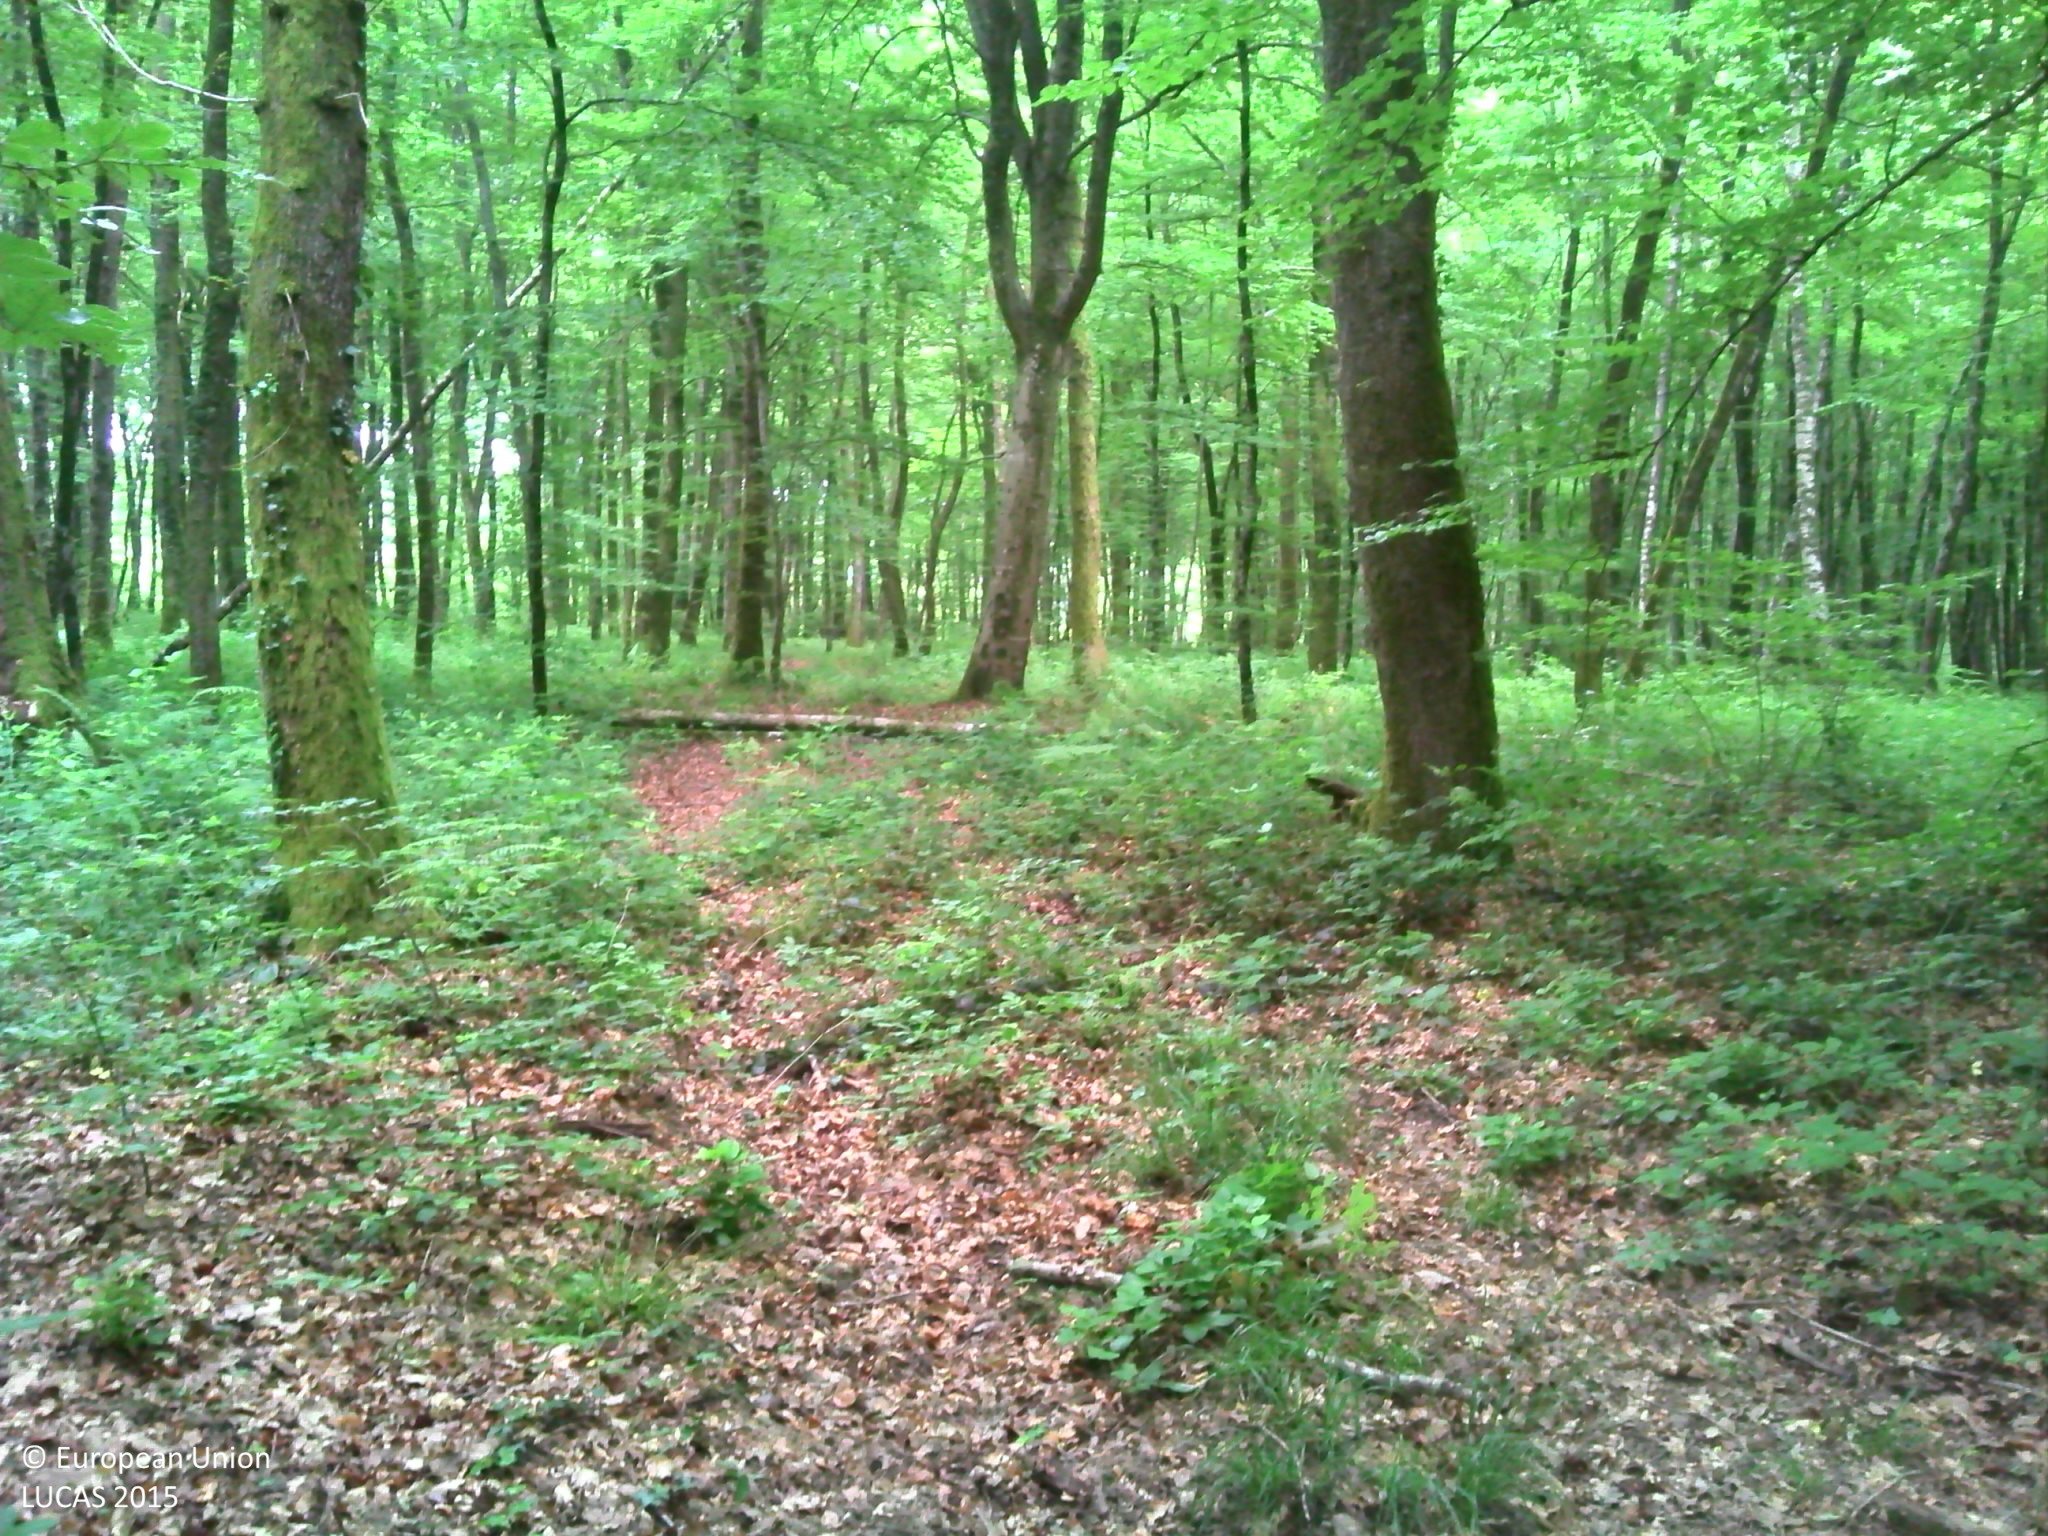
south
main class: Woodland
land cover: Broadleaved woodland
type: beech forest
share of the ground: > 75 %
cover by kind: broadleaved forest trees 95 %, herbaceous plants 5 %
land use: Forestry
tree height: > 5 m
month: June
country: FR
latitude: 47.7409
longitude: 6.1202
